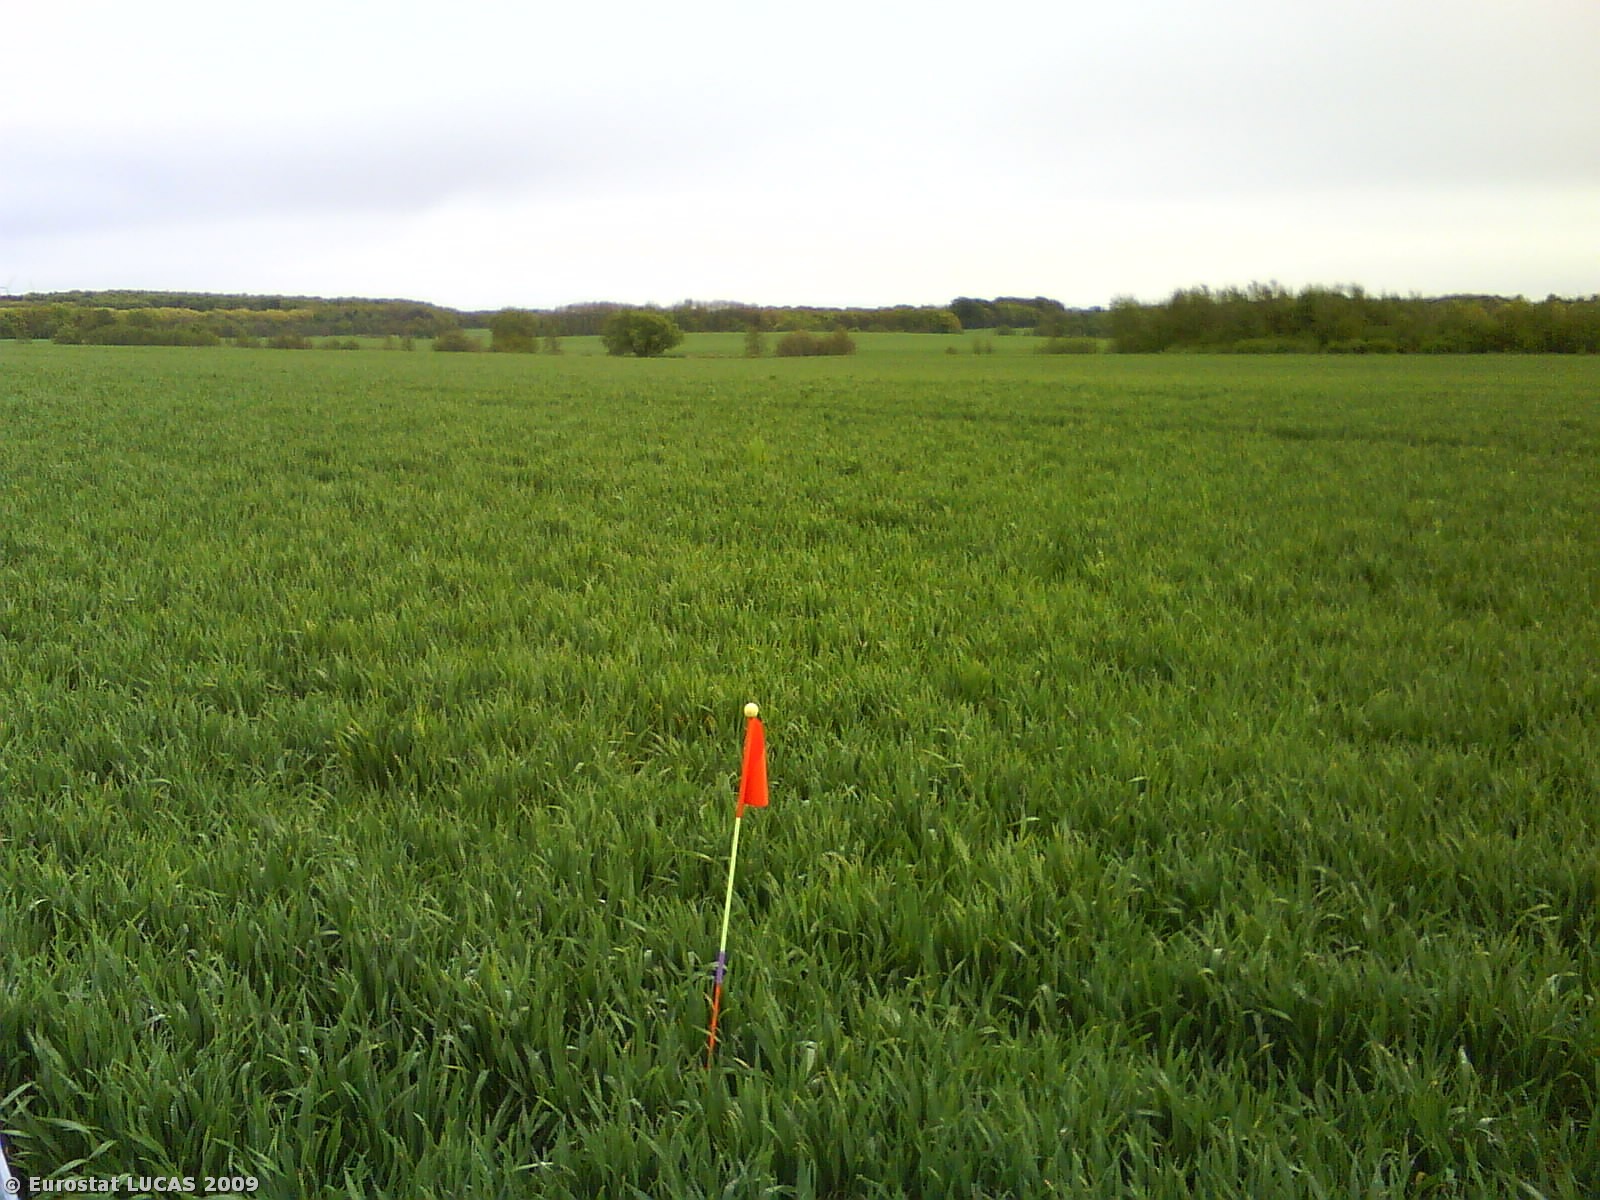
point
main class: Cropland
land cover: Common wheat
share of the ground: > 75 %
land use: Agriculture (excluding fallow land and kitchen gardens)
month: May
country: DK
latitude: 56.3314
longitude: 10.2100
